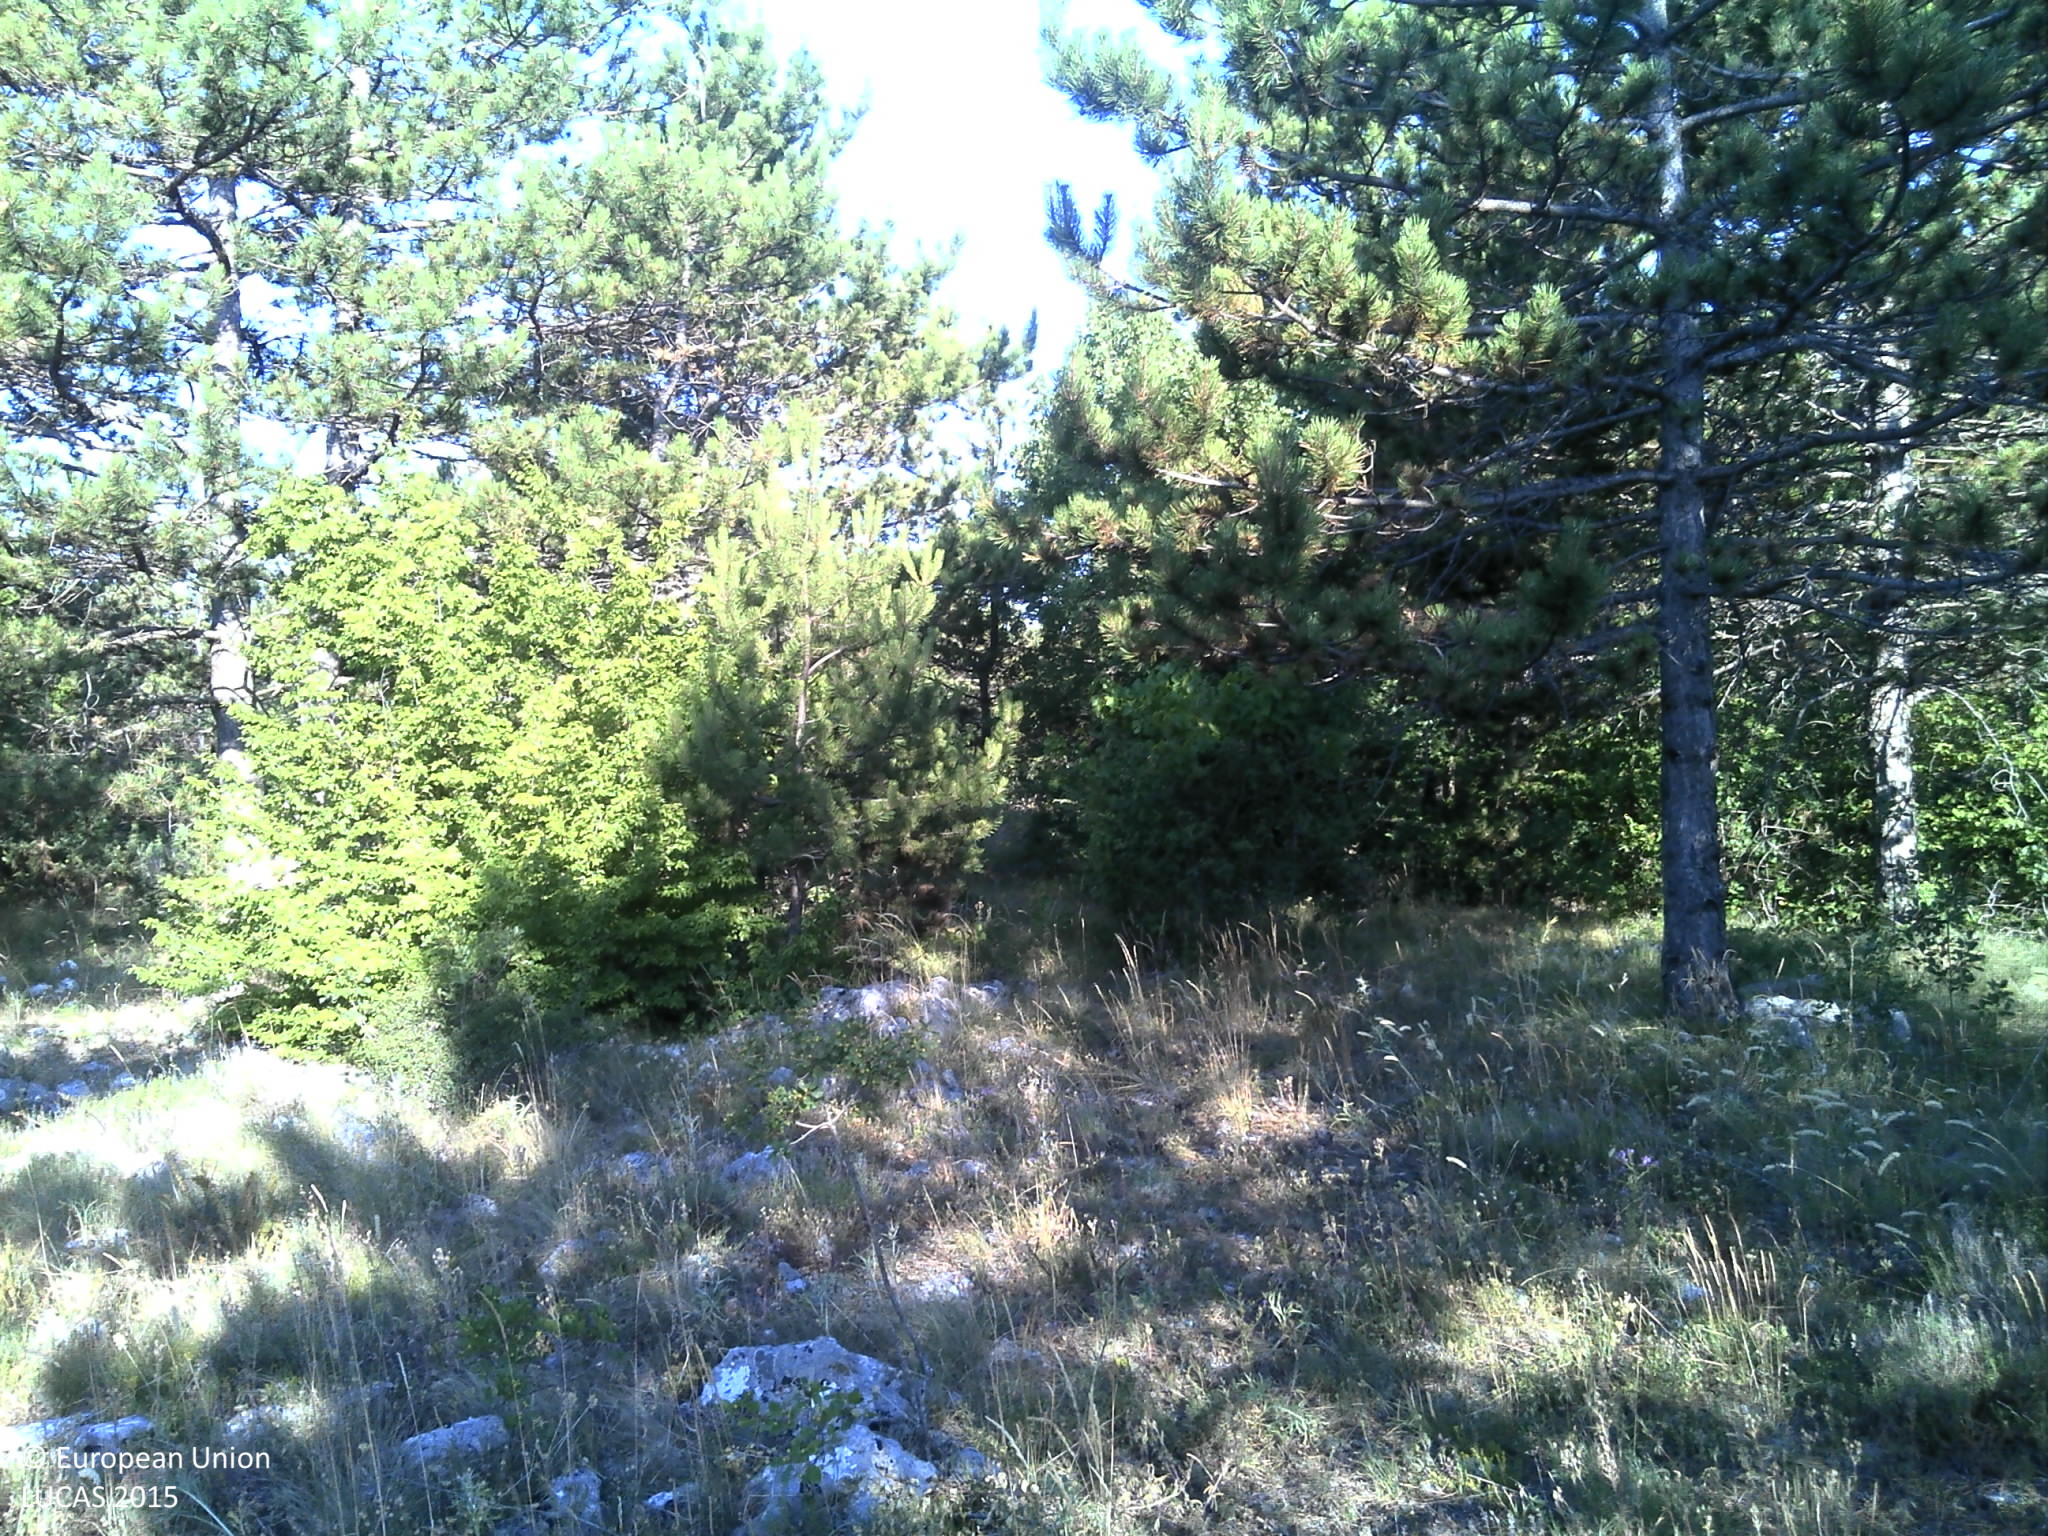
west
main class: Woodland
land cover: Pine dominated coniferous woodland
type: coniferous forest of the mediterranean region
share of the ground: 50 - 75 %
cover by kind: coniferous forest trees 60 %, herbaceous plants 25 %, shrubs 5 %, consolidated bare surface 5 %, unconsolidated bare surface 5 %
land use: Semi-natural and natural areas not in use
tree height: > 5 m
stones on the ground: < 10 %
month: July
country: HR
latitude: 43.4983
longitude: 17.0039
